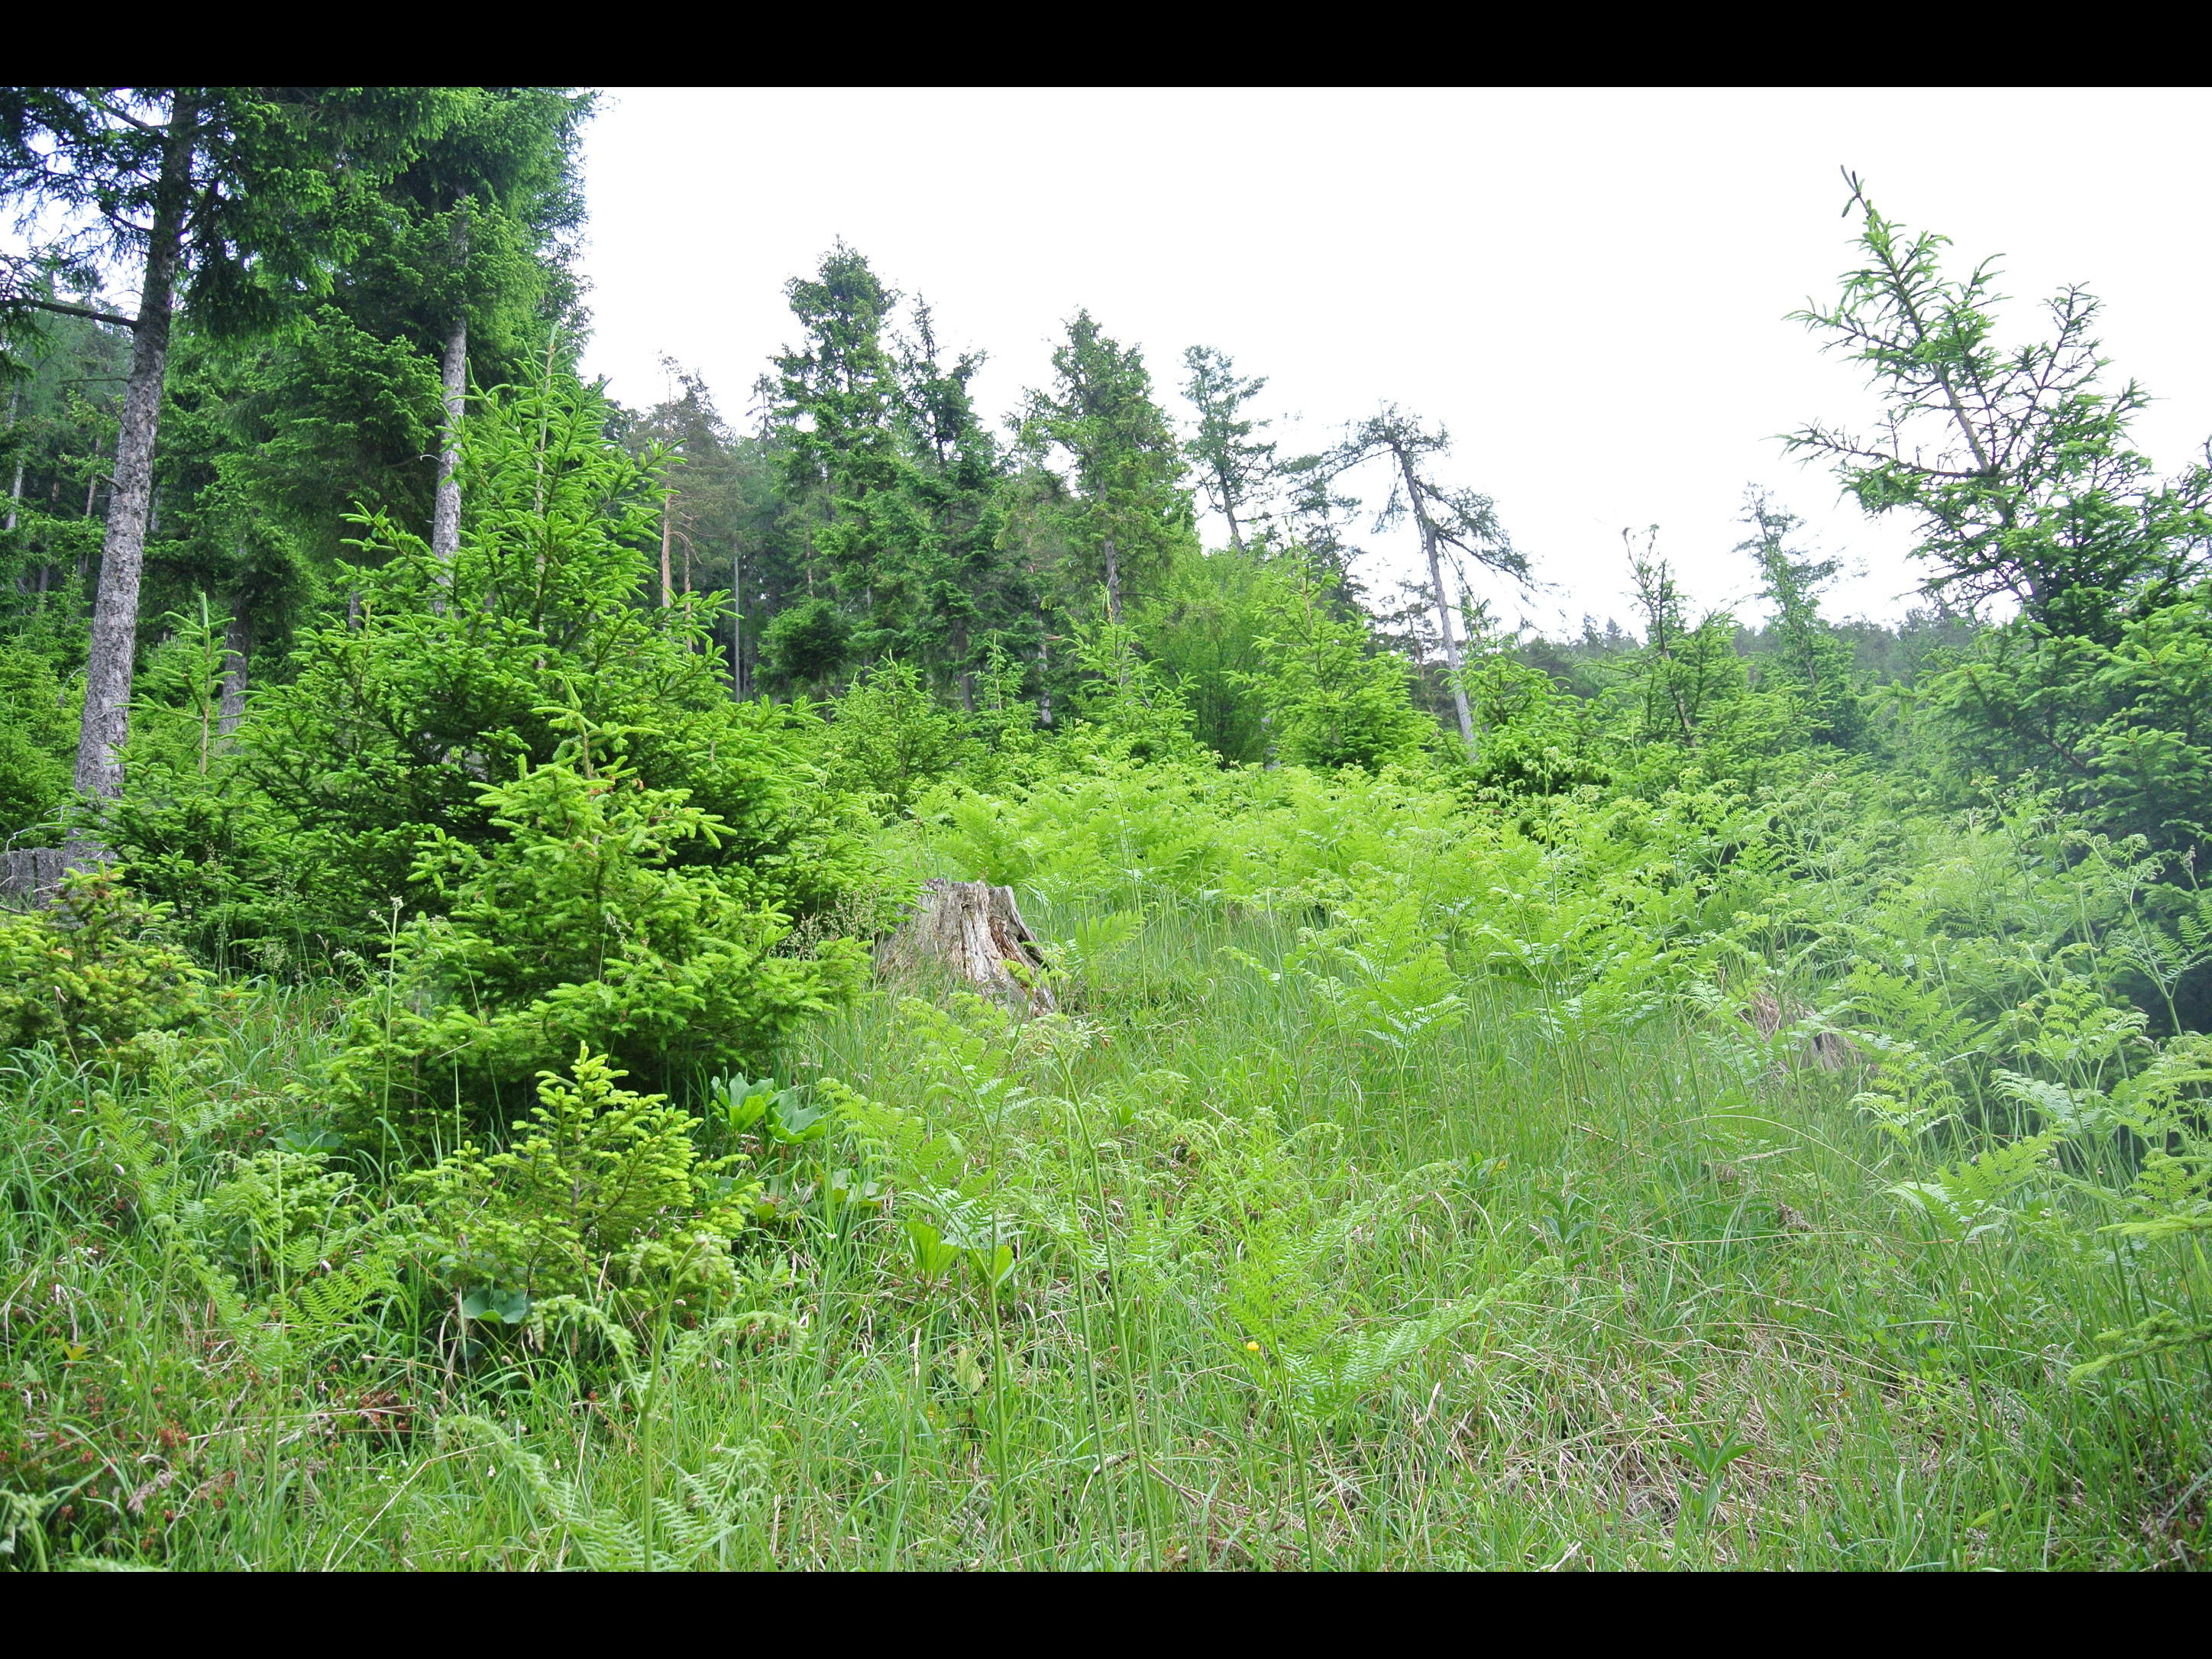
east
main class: Woodland
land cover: Spruce dominated coniferous woodland
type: alpine coniferous forest
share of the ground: > 75 %
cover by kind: coniferous forest trees 75 %, herbaceous plants 20 %, shrubs 5 %
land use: Forestry
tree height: < 5 m
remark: Clear cut
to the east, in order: Spruce dominated coniferous woodland; Tracks; Spruce dominated coniferous woodland; Tracks; Rocks and stones; Spruce dominated coniferous woodland; Tracks
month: June
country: AT
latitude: 47.8549
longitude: 15.7896
